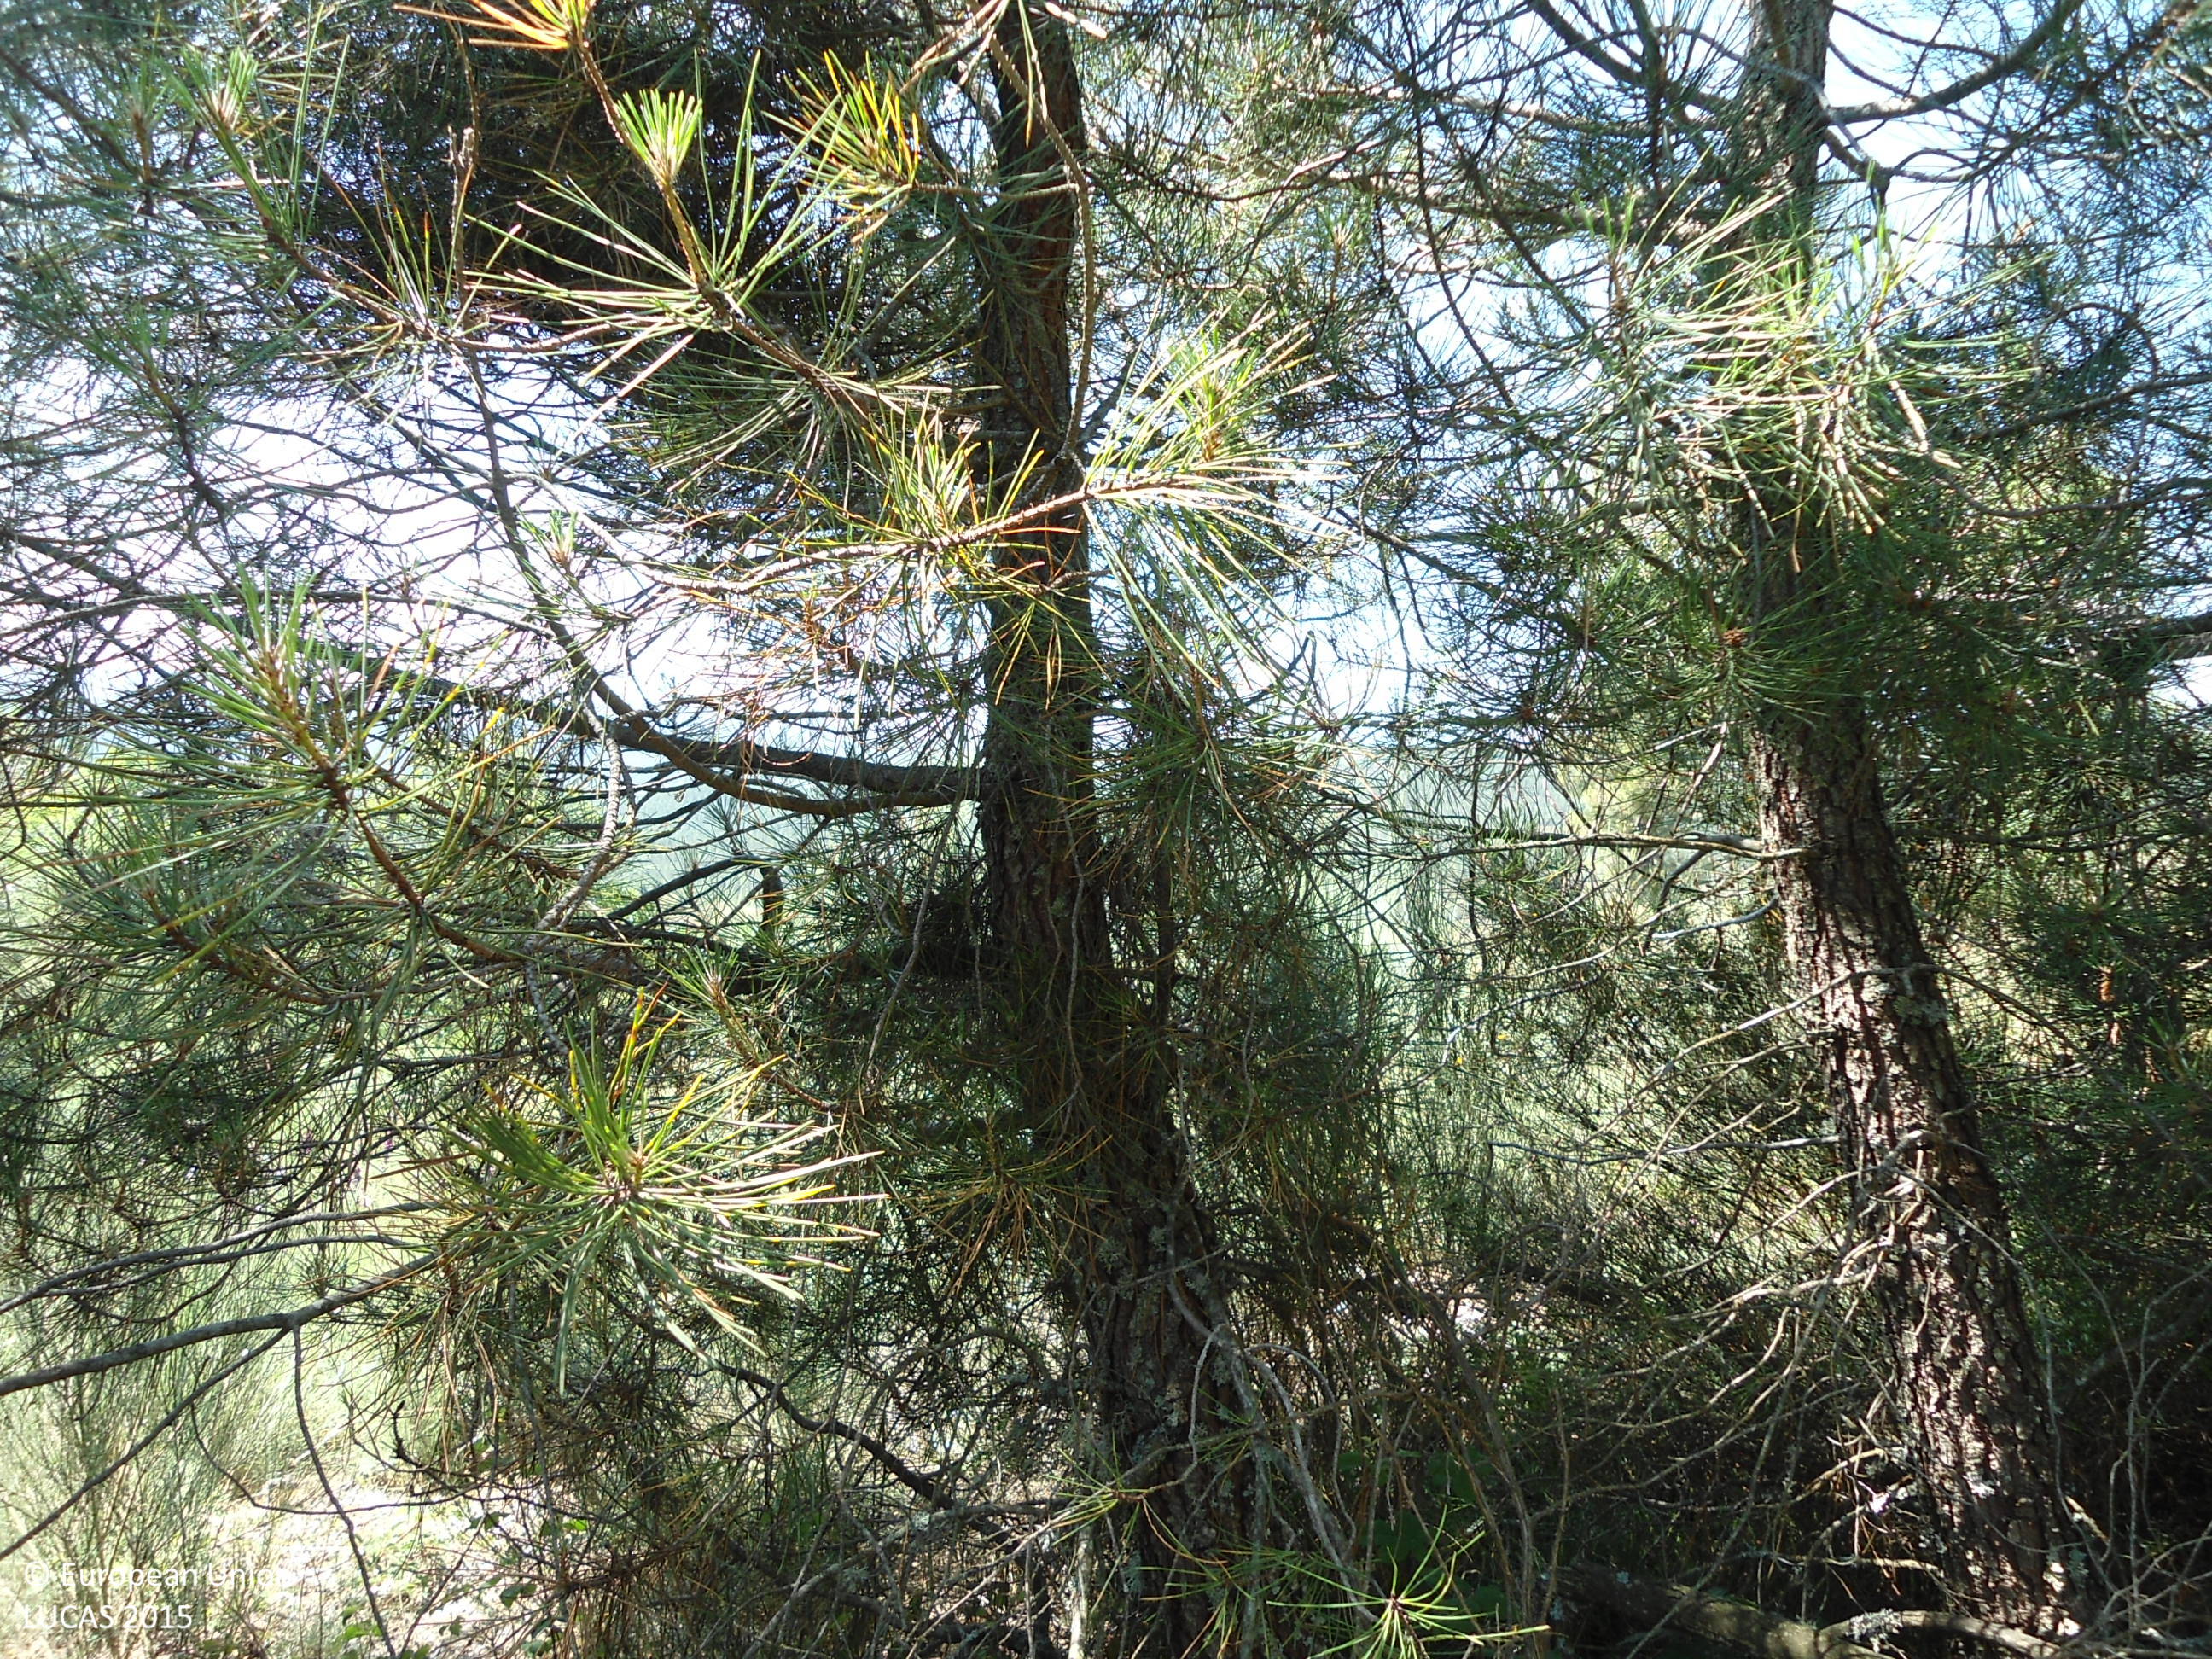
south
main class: Woodland
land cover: Pine dominated coniferous woodland
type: coniferous forest of the mediterranean region
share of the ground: 25 - 50 %
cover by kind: shrubs 70 %, coniferous forest trees 30 %
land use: Forestry
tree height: > 5 m
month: June
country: ES
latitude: 41.9146
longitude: -7.2598
